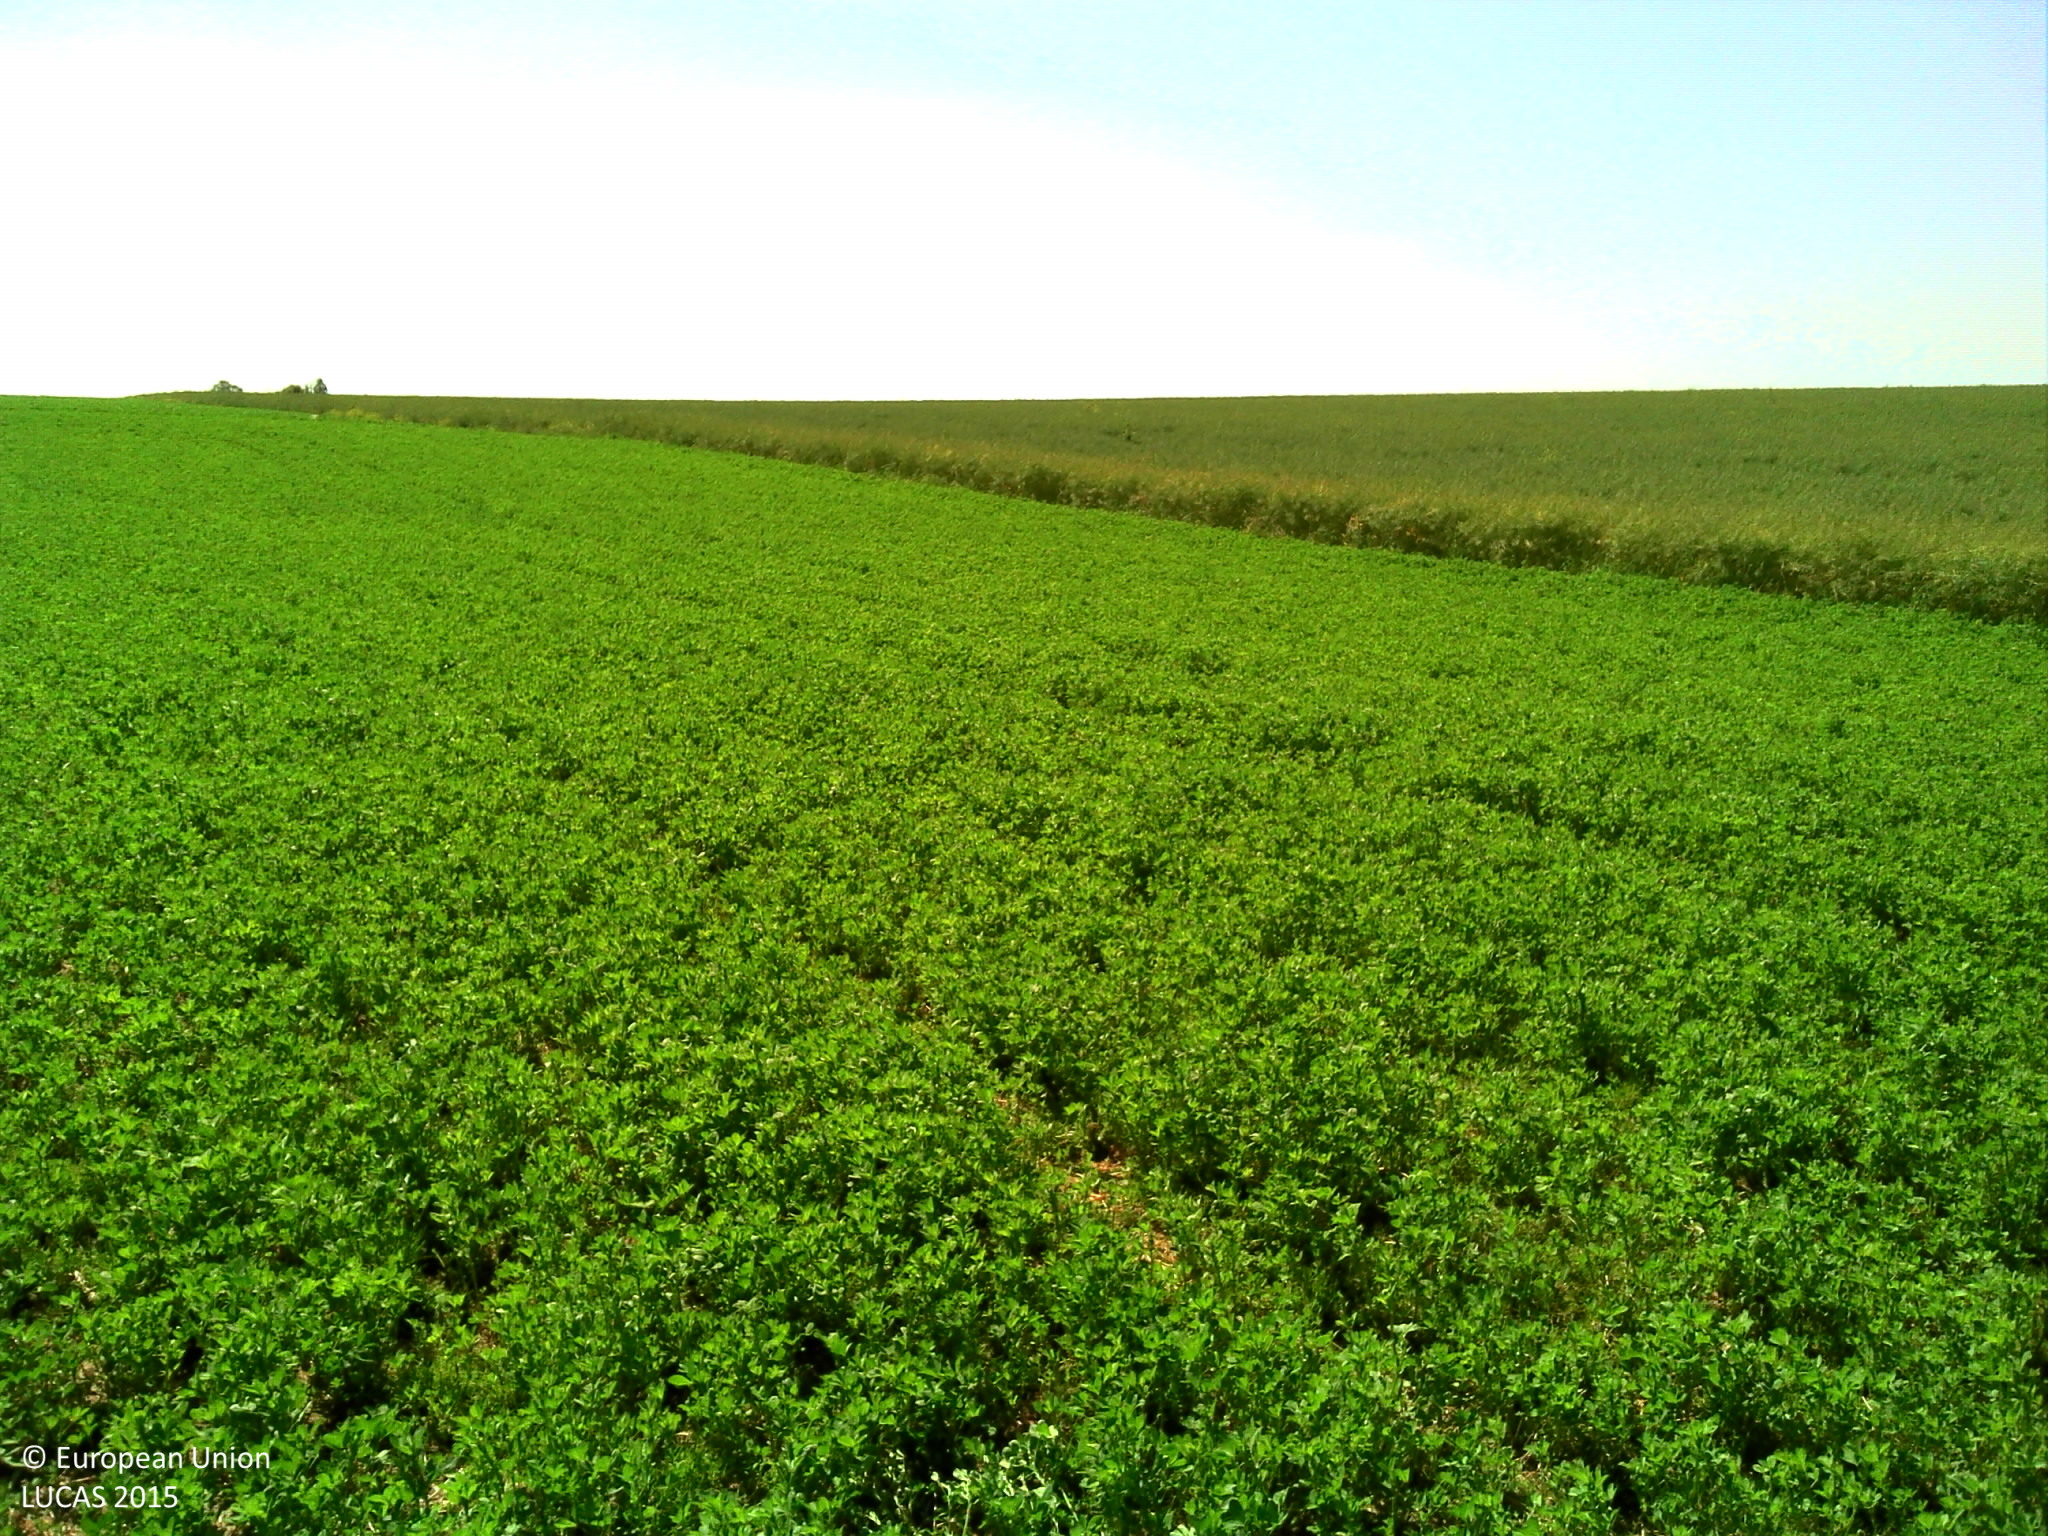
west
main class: Cropland
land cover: Lucerne
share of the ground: > 75 %
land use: Agriculture (excluding fallow land and kitchen gardens)
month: June
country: FR
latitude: 50.7424
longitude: 2.1200
